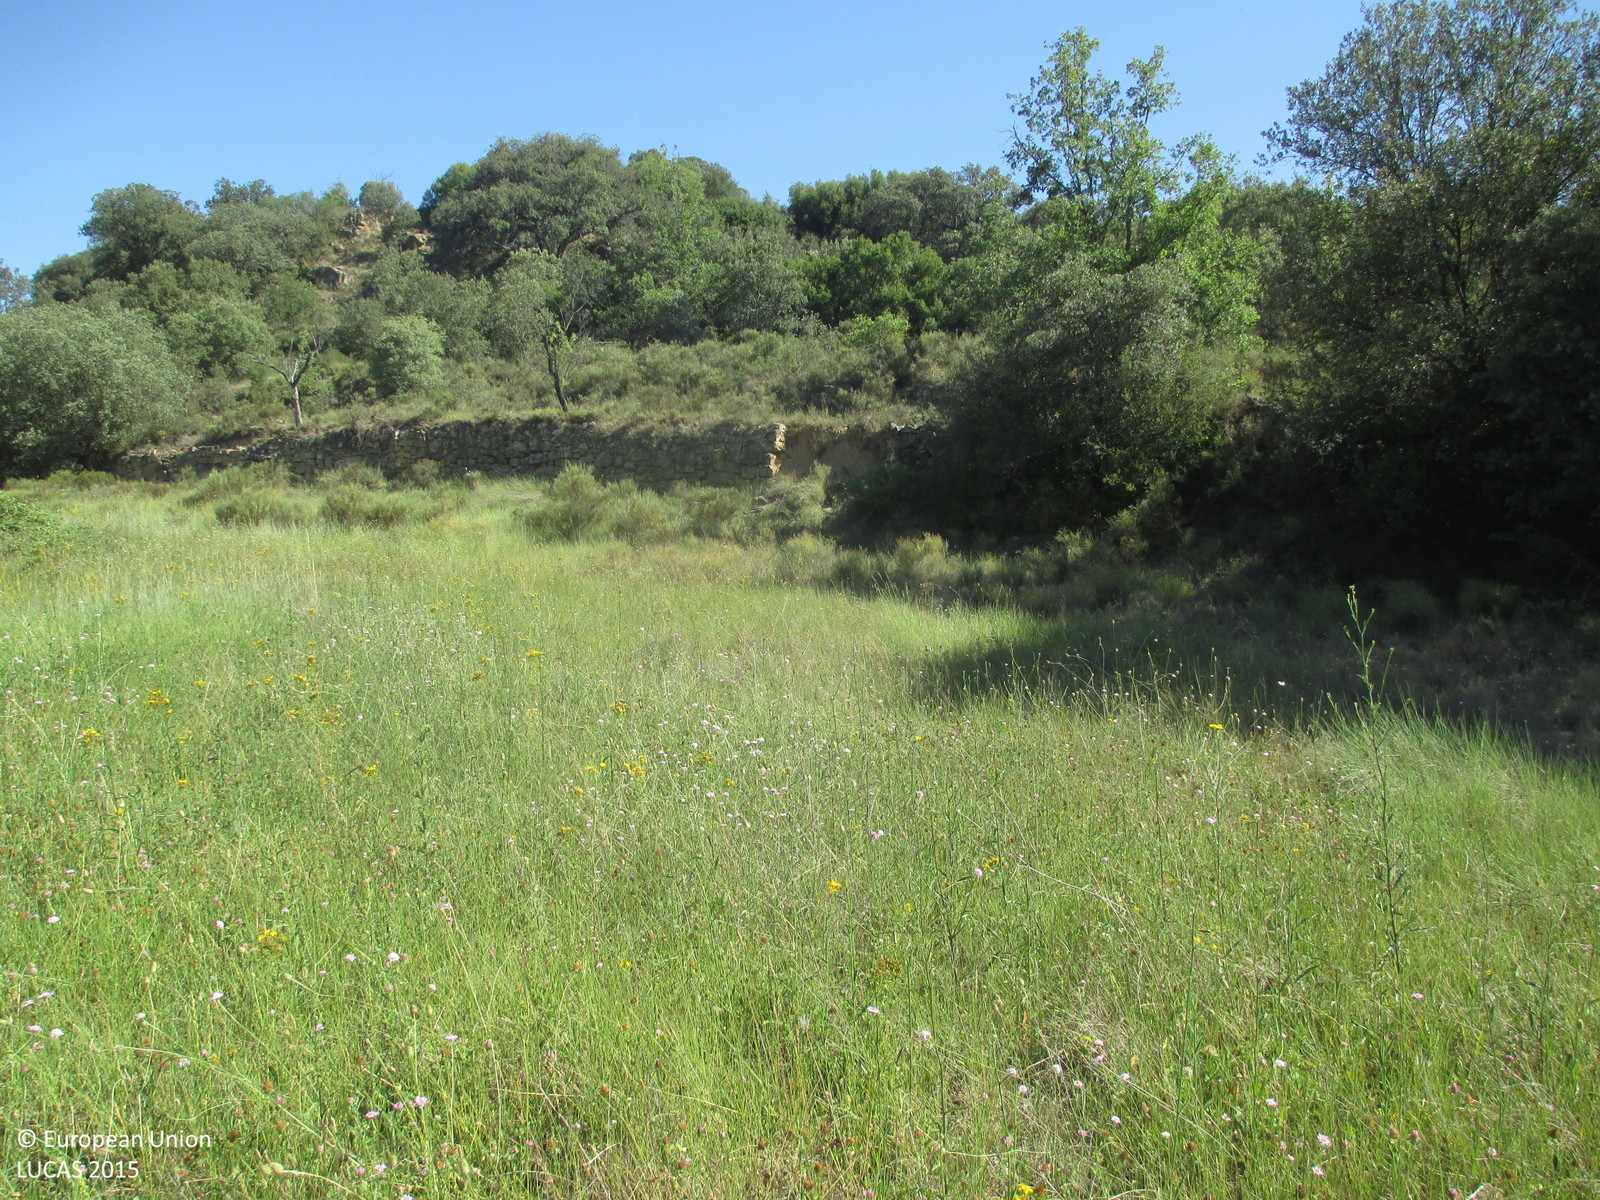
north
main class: Grassland
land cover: Grassland with sparse tree/shrub cover
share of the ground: > 75 %
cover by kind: herbaceous plants 90 %, broadleaved forest trees 5 %, shrubs 5 %
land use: Semi-natural and natural areas not in use
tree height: < 5 m
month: June
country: ES
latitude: 42.1575
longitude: -0.0047
